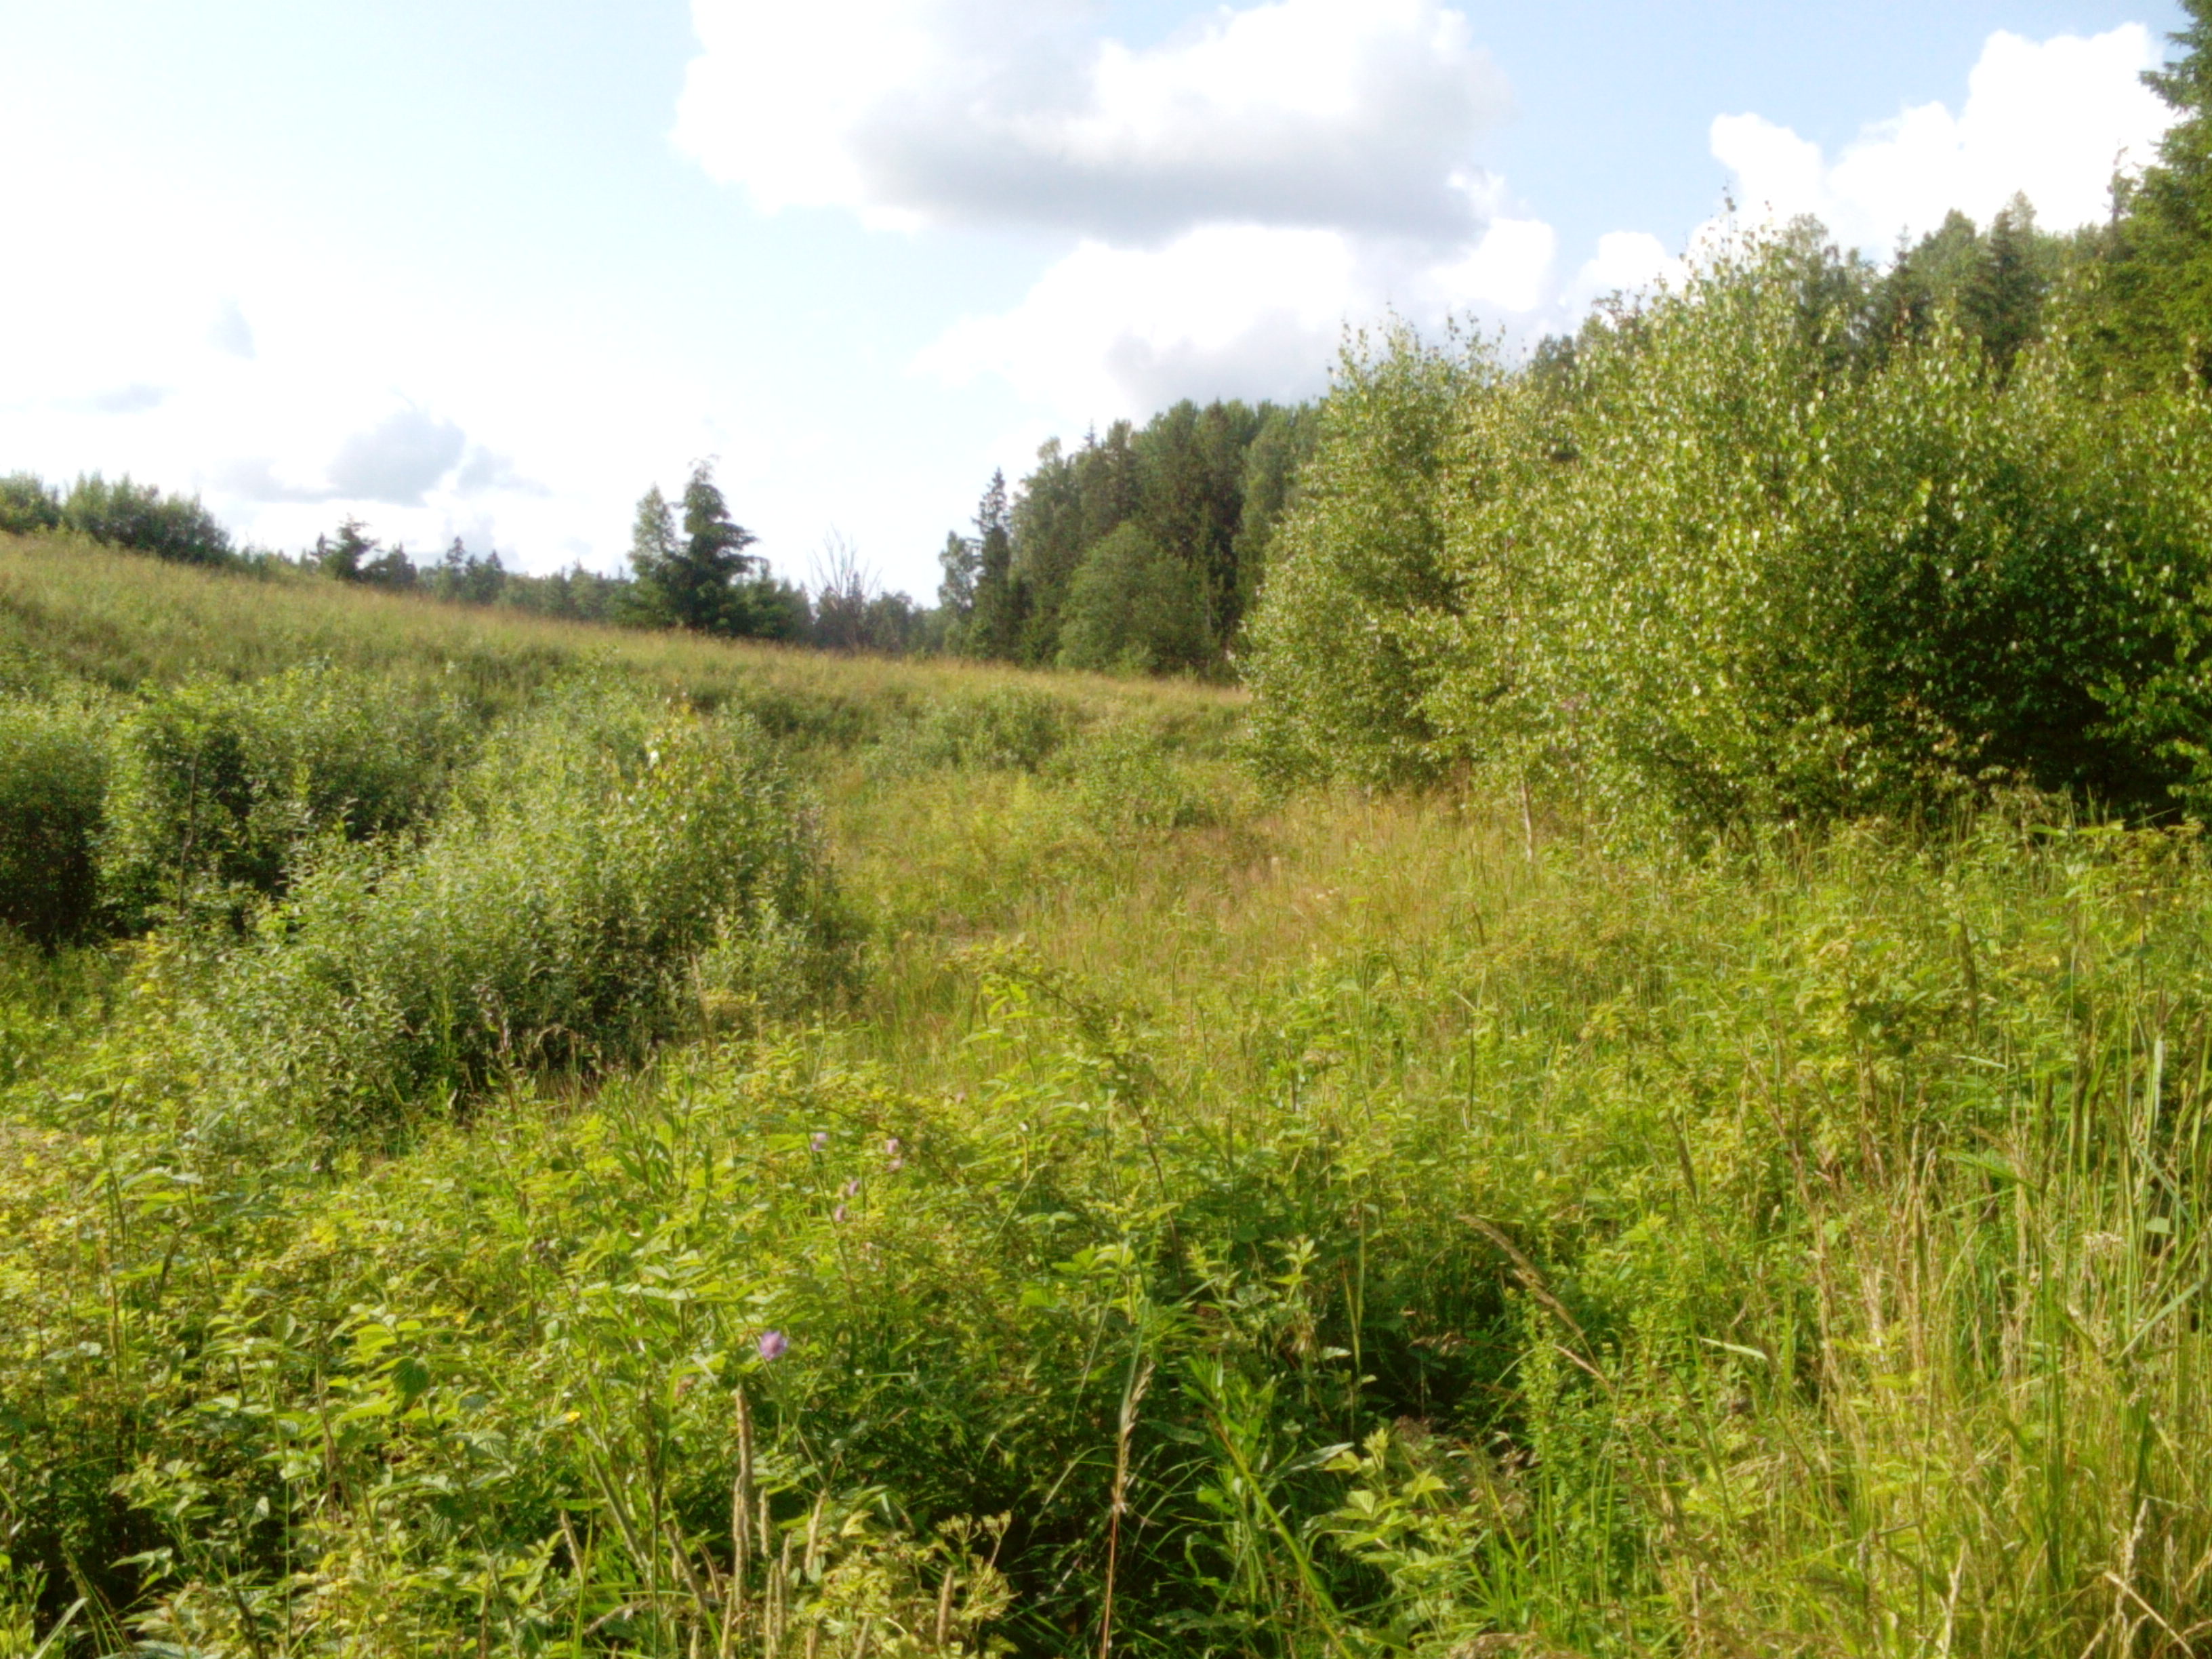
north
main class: Shrubland
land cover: Shrubland with sparse tree cover
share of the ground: 50 - 75 %
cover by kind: shrubs 50 %, herbaceous plants 45 %, broadleaved forest trees 5 %
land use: Semi-natural and natural areas not in use
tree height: < 5 m
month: July
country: LV
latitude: 56.5737
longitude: 21.7485
